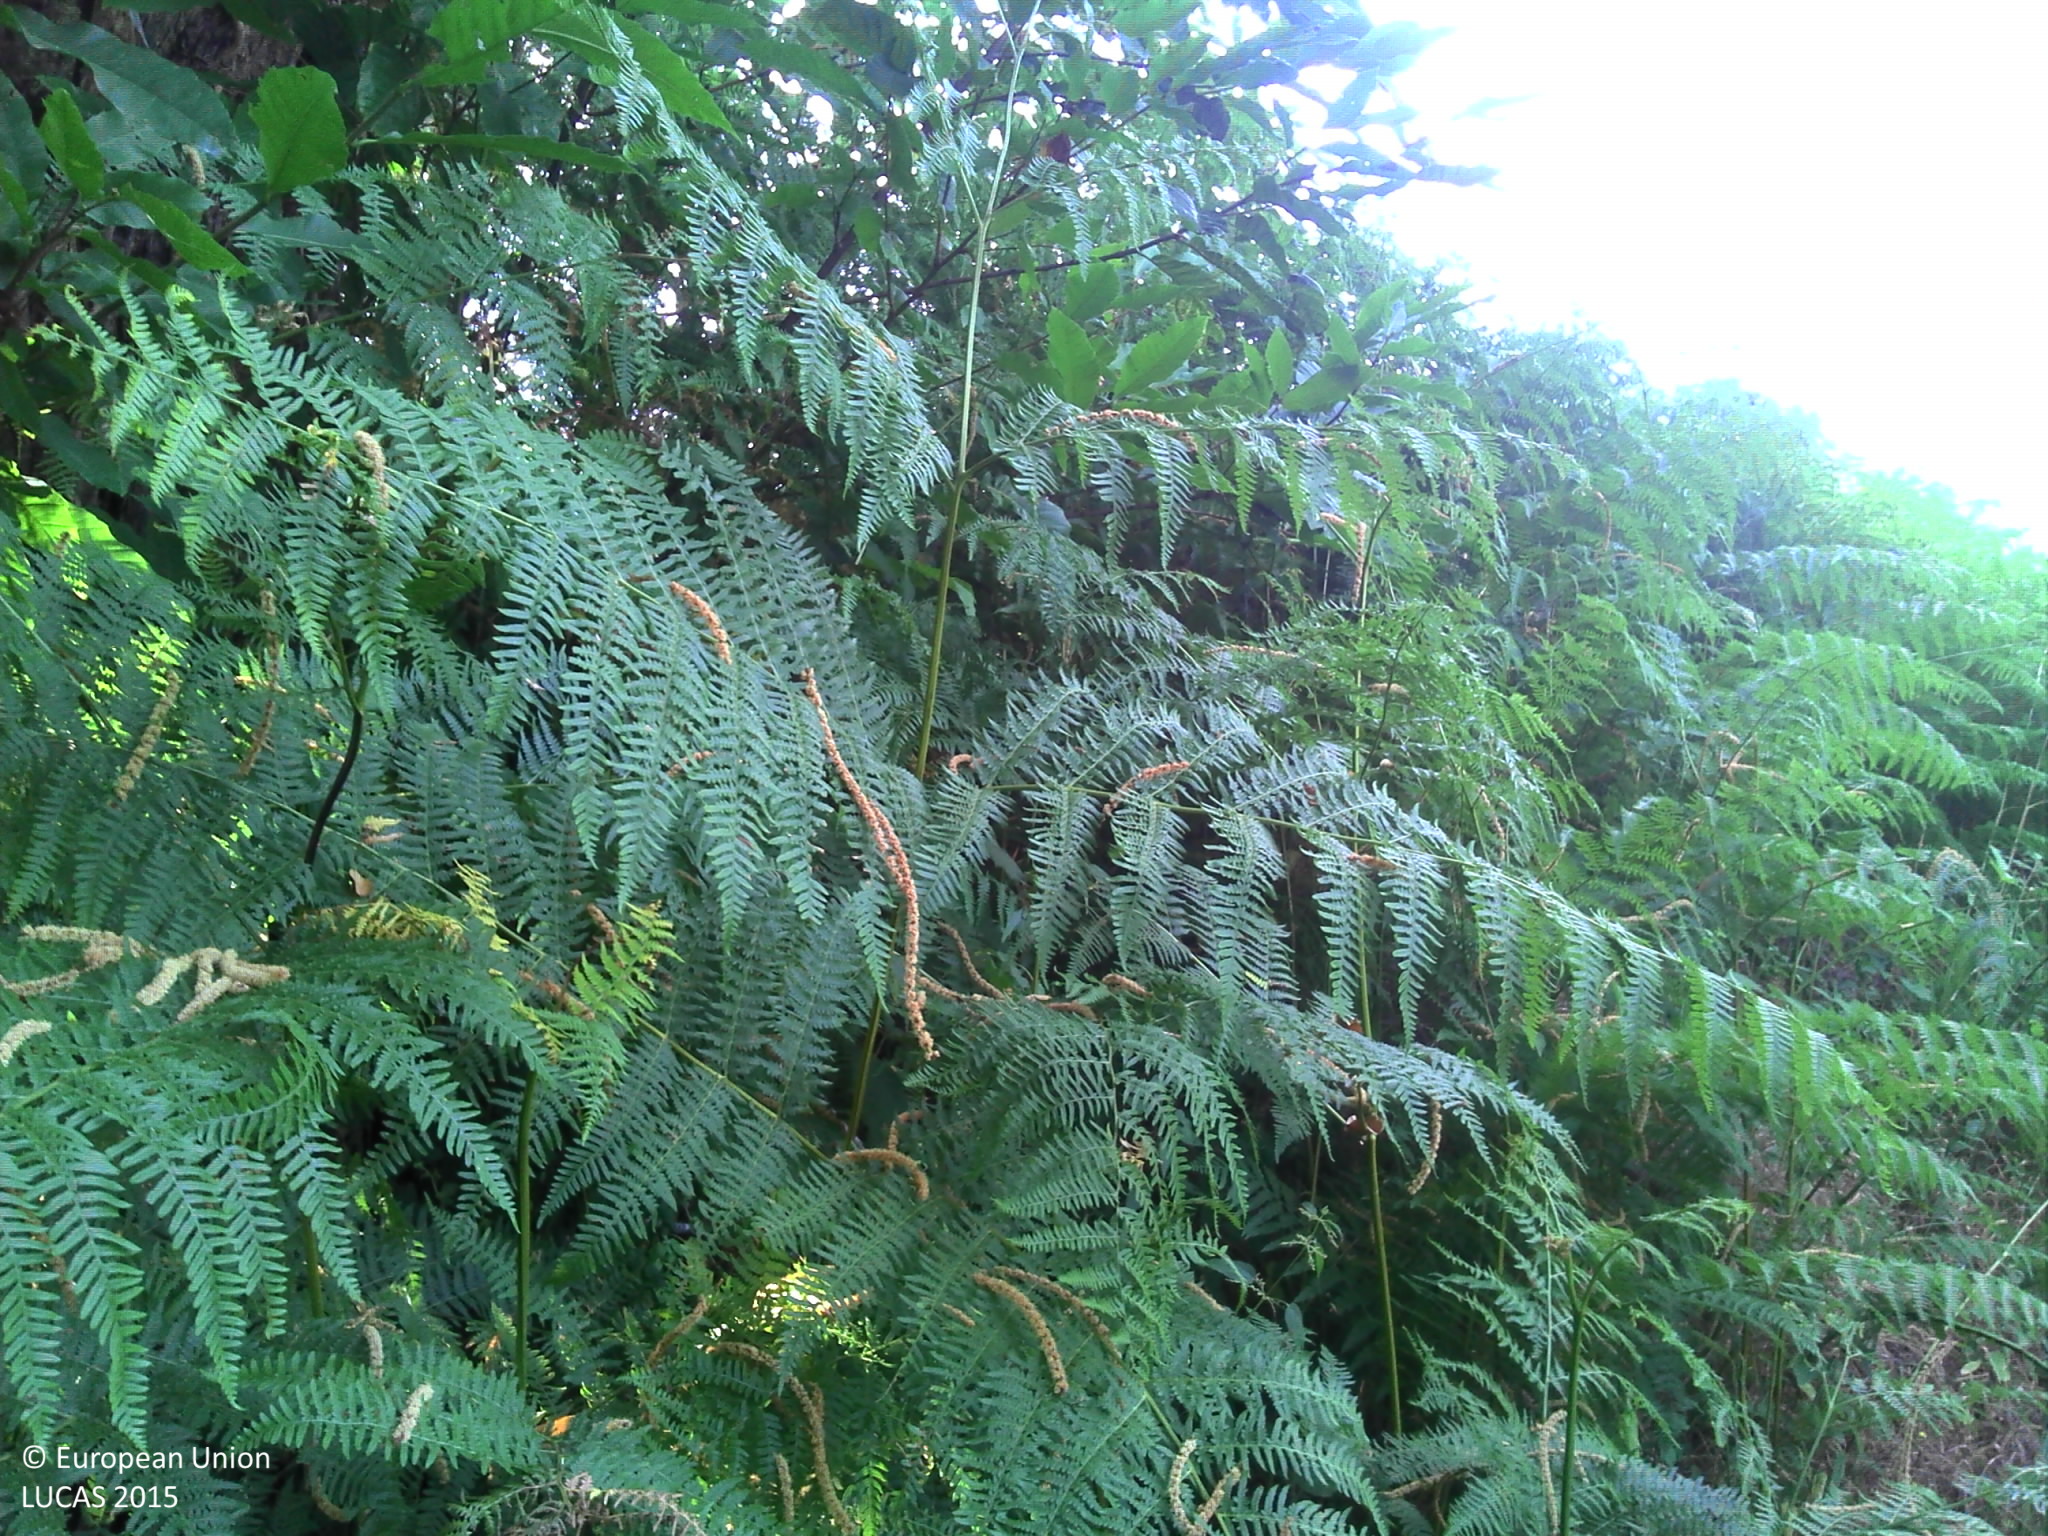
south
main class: Woodland
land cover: Broadleaved woodland
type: mesophytic deciduous forest
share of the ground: 50 - 75 %
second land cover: Spontaneously vegetated surfaces
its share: > 75 %
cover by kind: broadleaved forest trees 60 %, shrubs 30 %, herbaceous plants 10 %
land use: Forestry
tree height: > 5 m
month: July
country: FR
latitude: 47.7078
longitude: 0.3404
